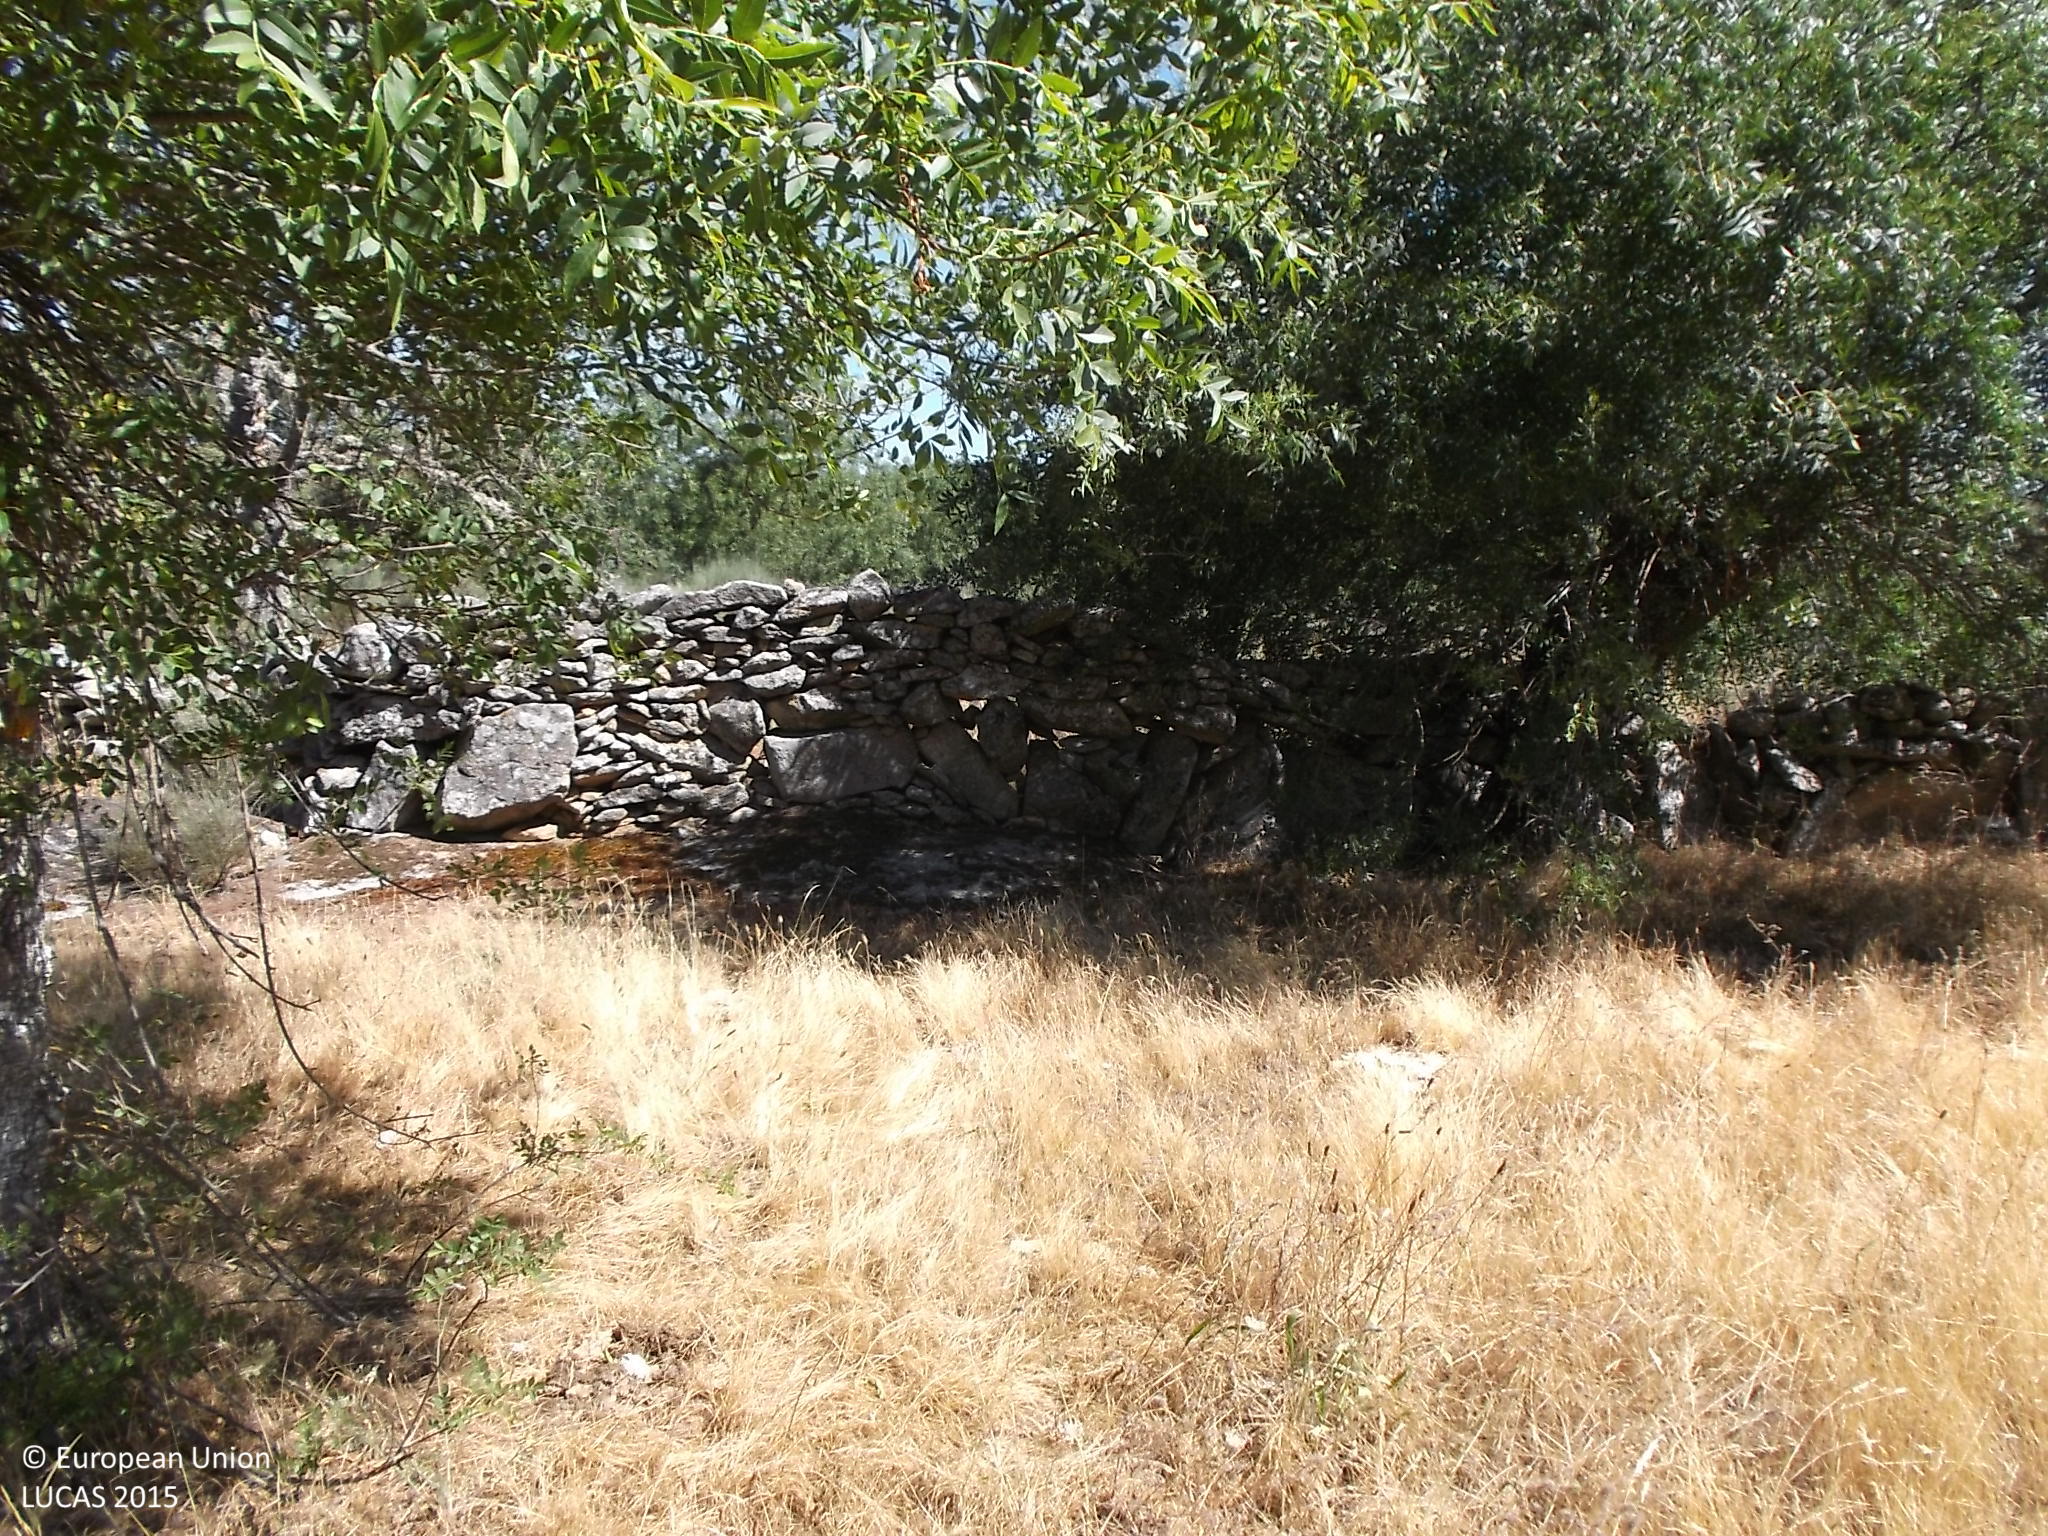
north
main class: Grassland
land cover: Grassland with sparse tree/shrub cover
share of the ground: > 75 %
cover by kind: herbaceous plants 90 %, broadleaved forest trees 5 %, shrubs 5 %
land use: Agriculture (excluding fallow land and kitchen gardens)
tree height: < 5 m
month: June
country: ES
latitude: 40.8972
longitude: -6.7531
